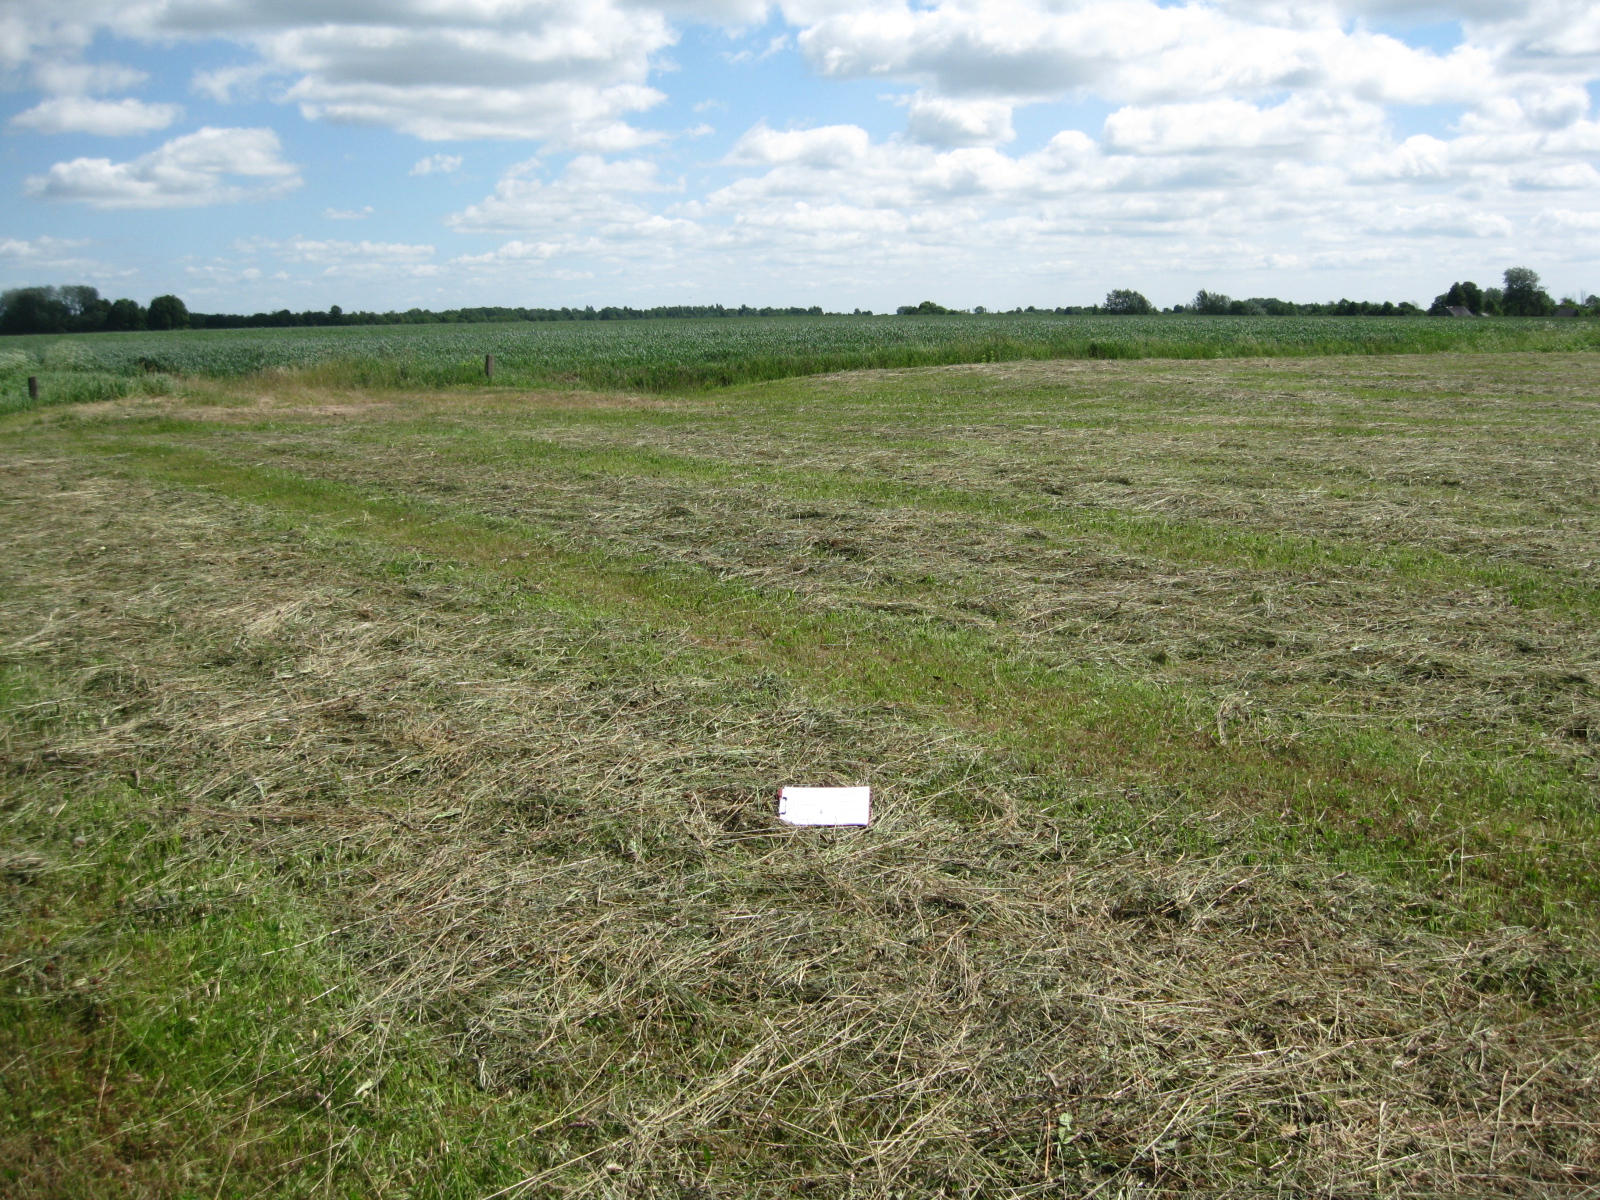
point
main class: Grassland
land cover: Grassland without tree/shrub cover
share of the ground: > 75 %
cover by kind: herbaceous plants 100 %
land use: Agriculture (excluding fallow land and kitchen gardens)
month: June
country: LT
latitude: 55.2137
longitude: 23.8389
